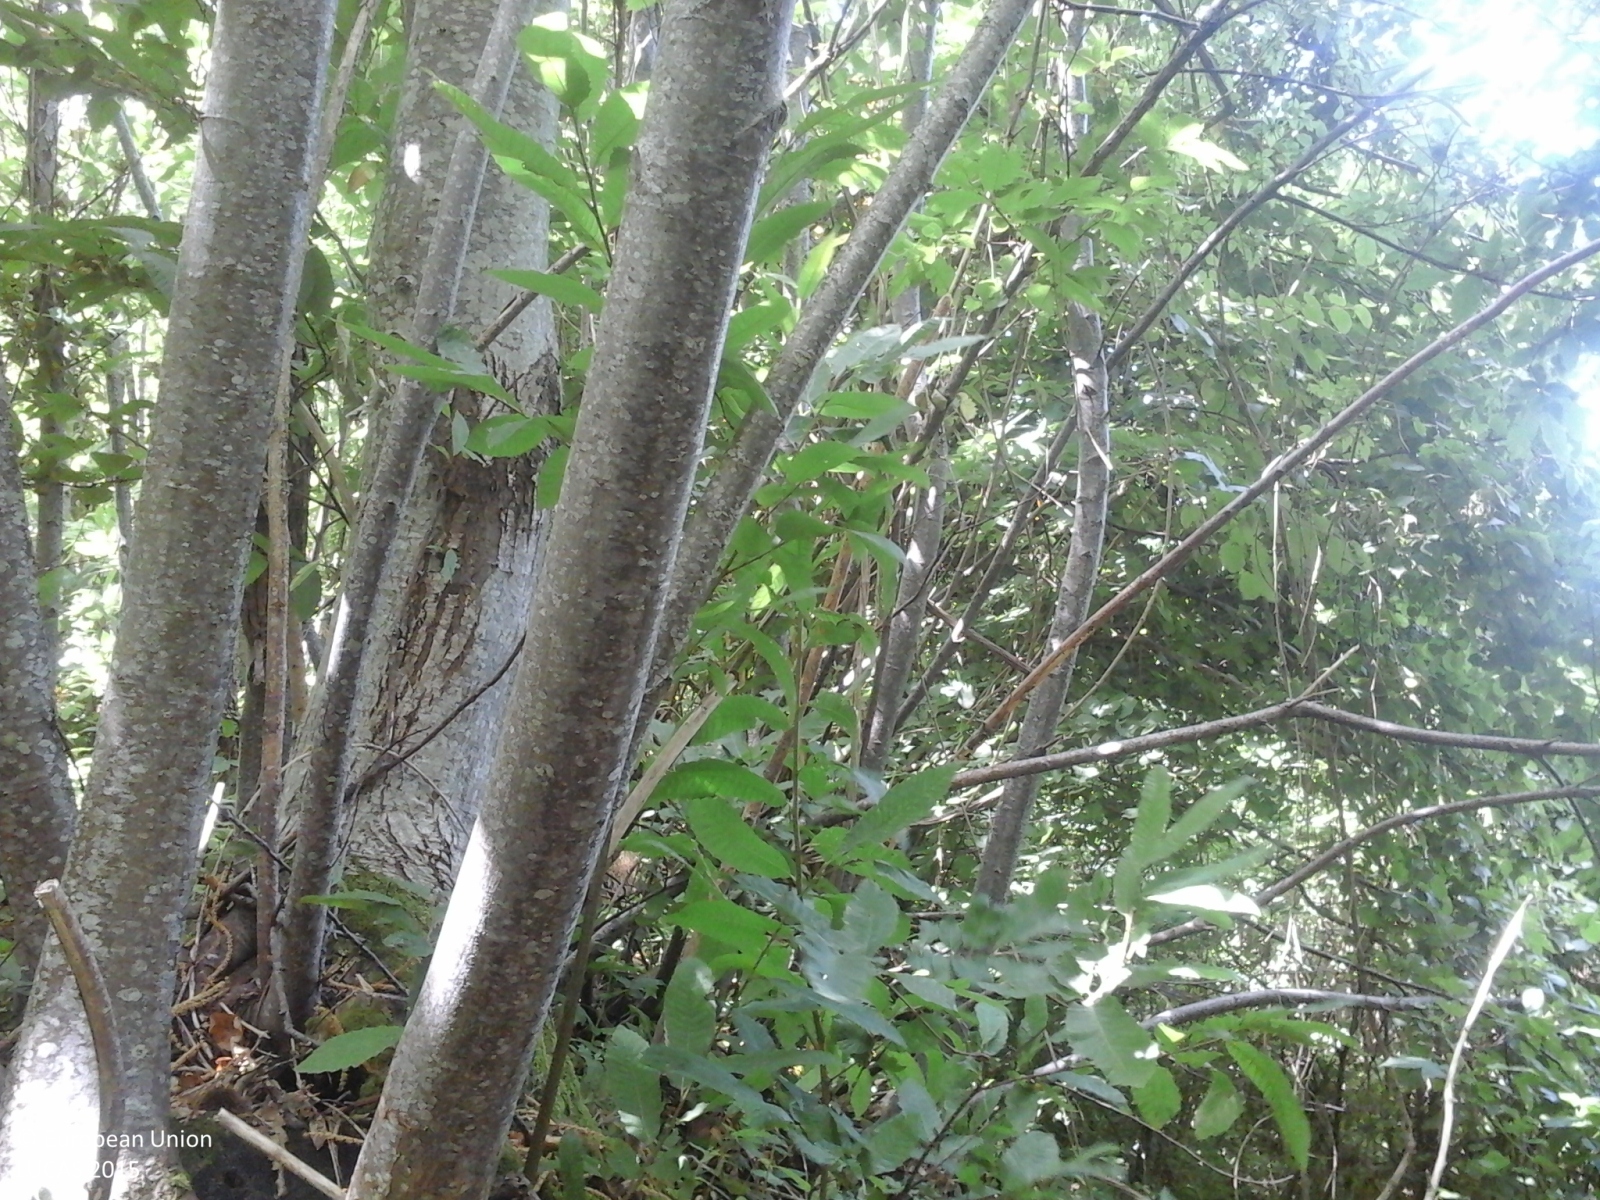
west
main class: Woodland
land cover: Broadleaved woodland
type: mesophytic deciduous forest
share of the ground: > 75 %
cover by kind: broadleaved forest trees 100 %
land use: Forestry
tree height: > 5 m
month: July
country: IT
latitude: 43.8576
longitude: 12.2215
